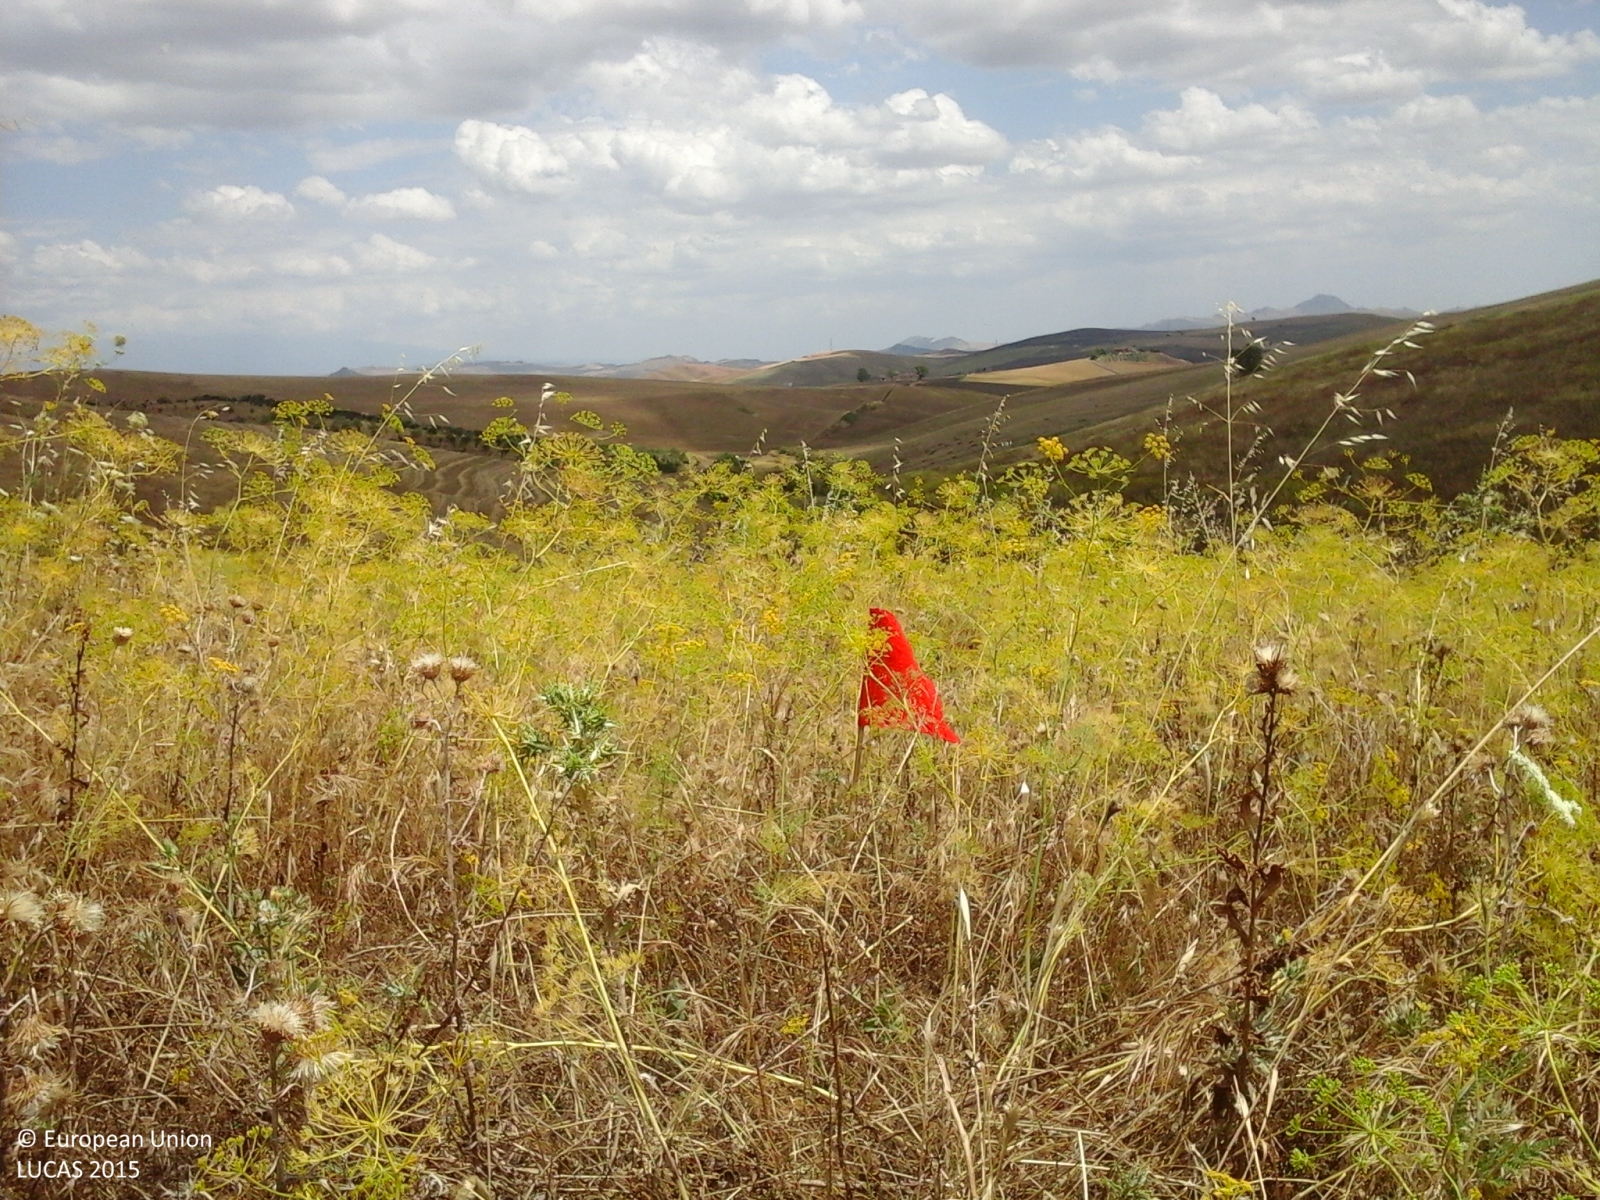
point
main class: Grassland
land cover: Grassland without tree/shrub cover
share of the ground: > 75 %
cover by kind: herbaceous plants 75 %, unconsolidated bare surface 25 %
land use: Agriculture (excluding fallow land and kitchen gardens)
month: June
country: IT
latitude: 37.5540
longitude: 14.4163
